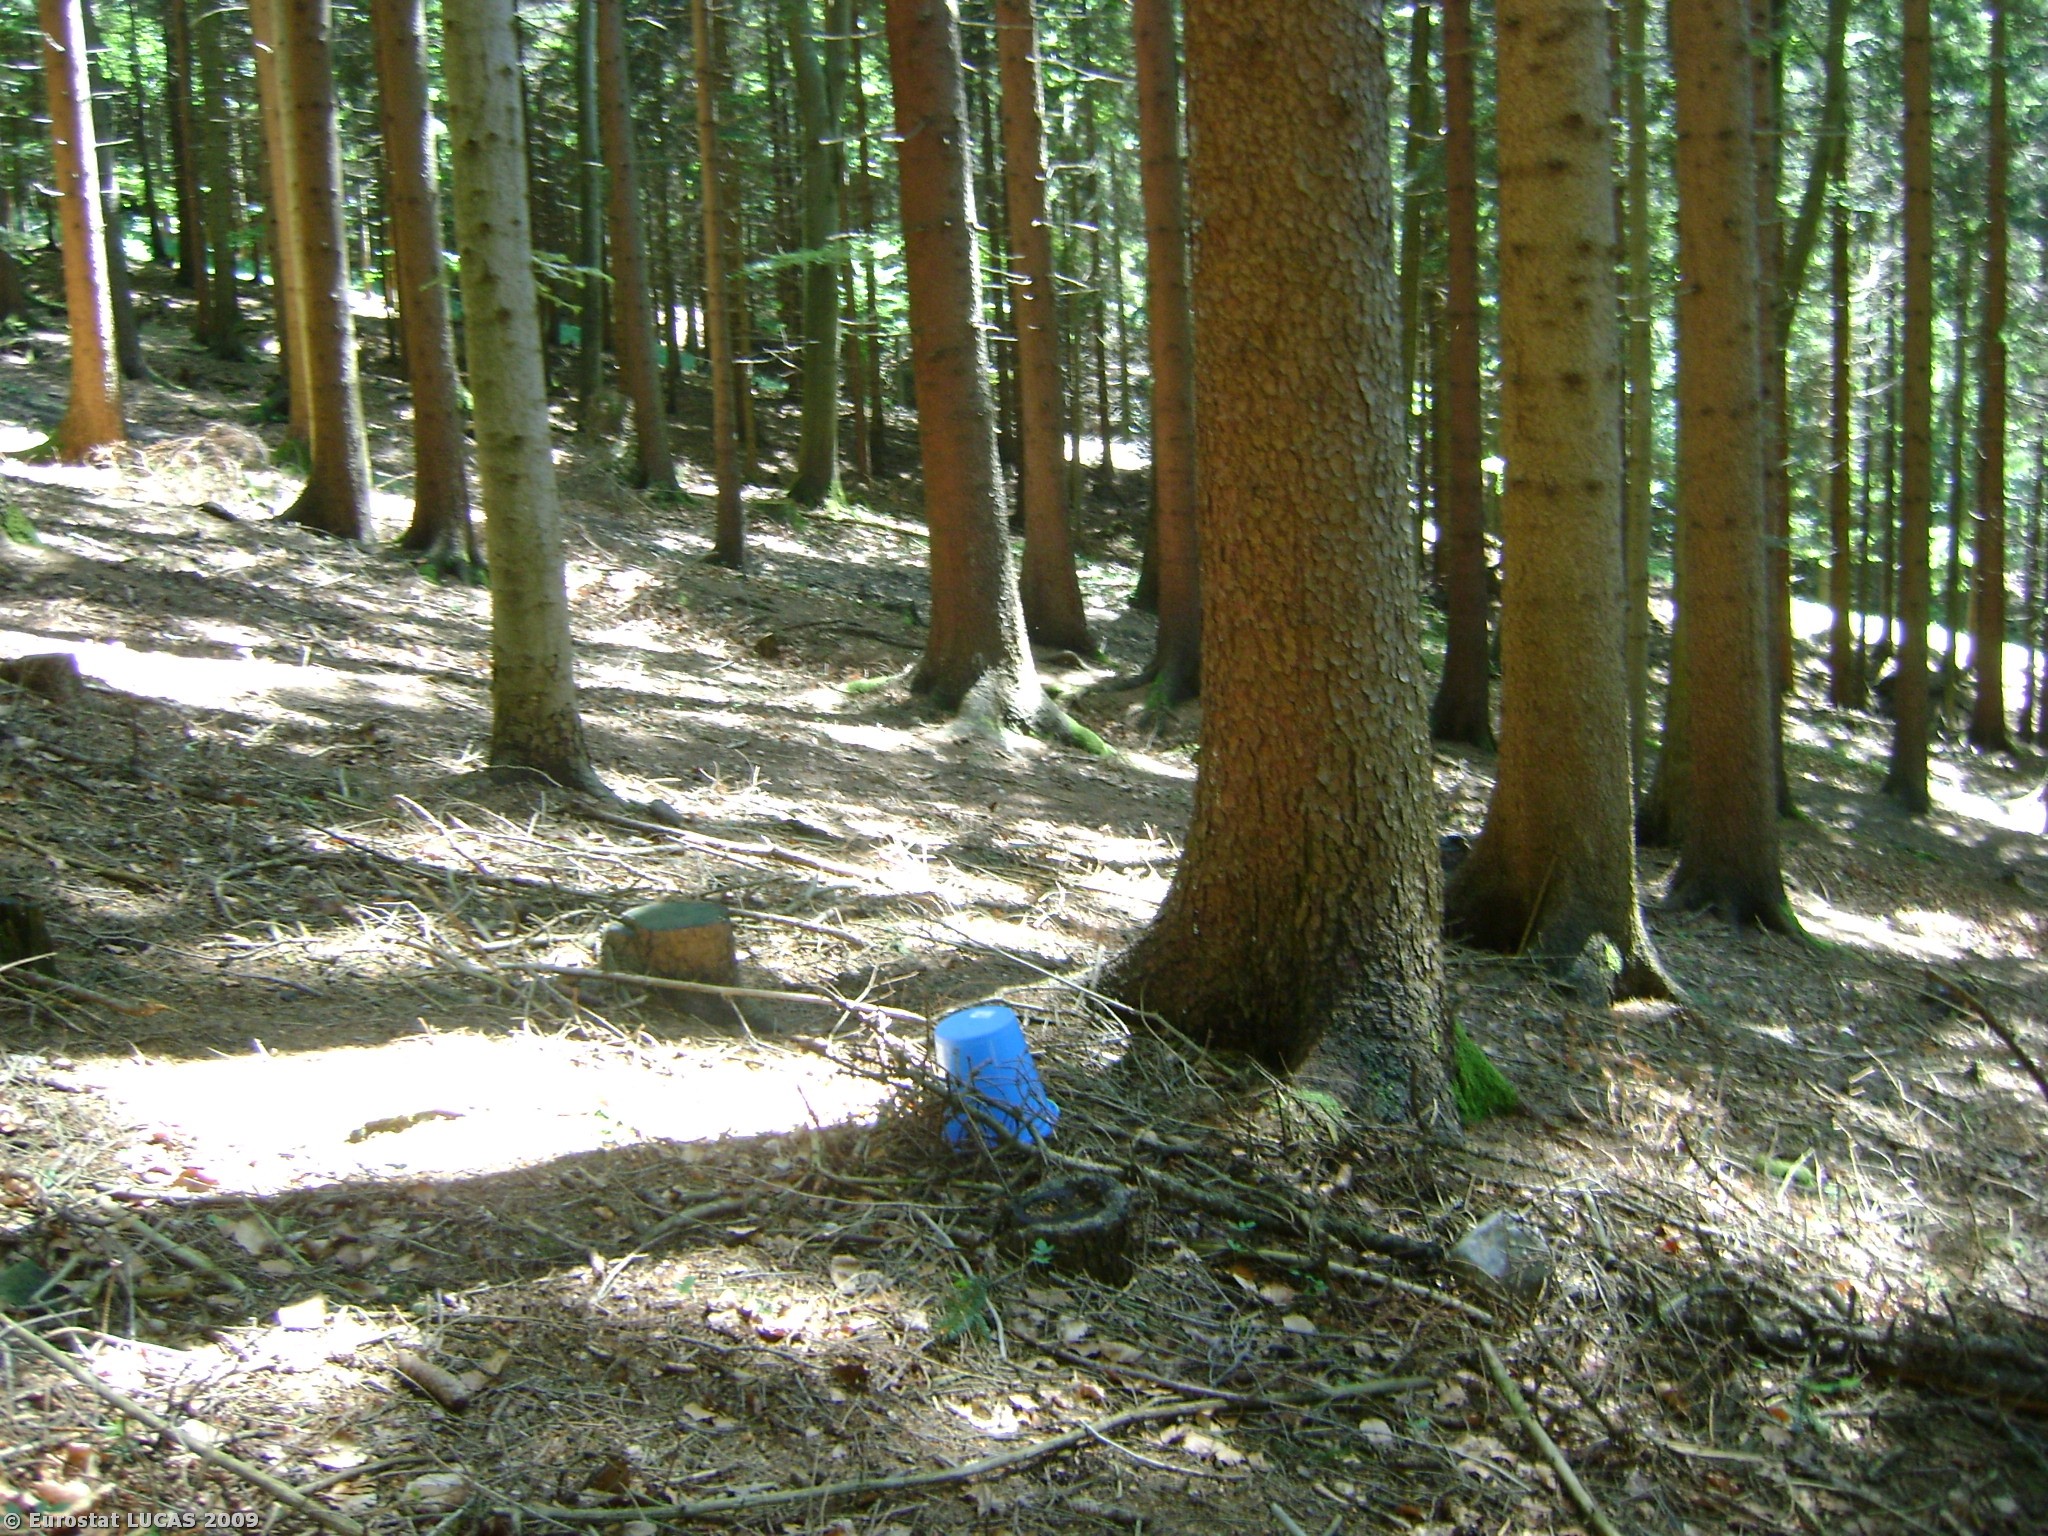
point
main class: Woodland
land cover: Coniferous woodland
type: hemiboreal forest and nemoral coniferous forest and mixed broadleaved-coniferous forest
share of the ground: > 75 %
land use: Forestry
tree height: > 5 m
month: May
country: AT
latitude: 47.9332
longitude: 13.5193
